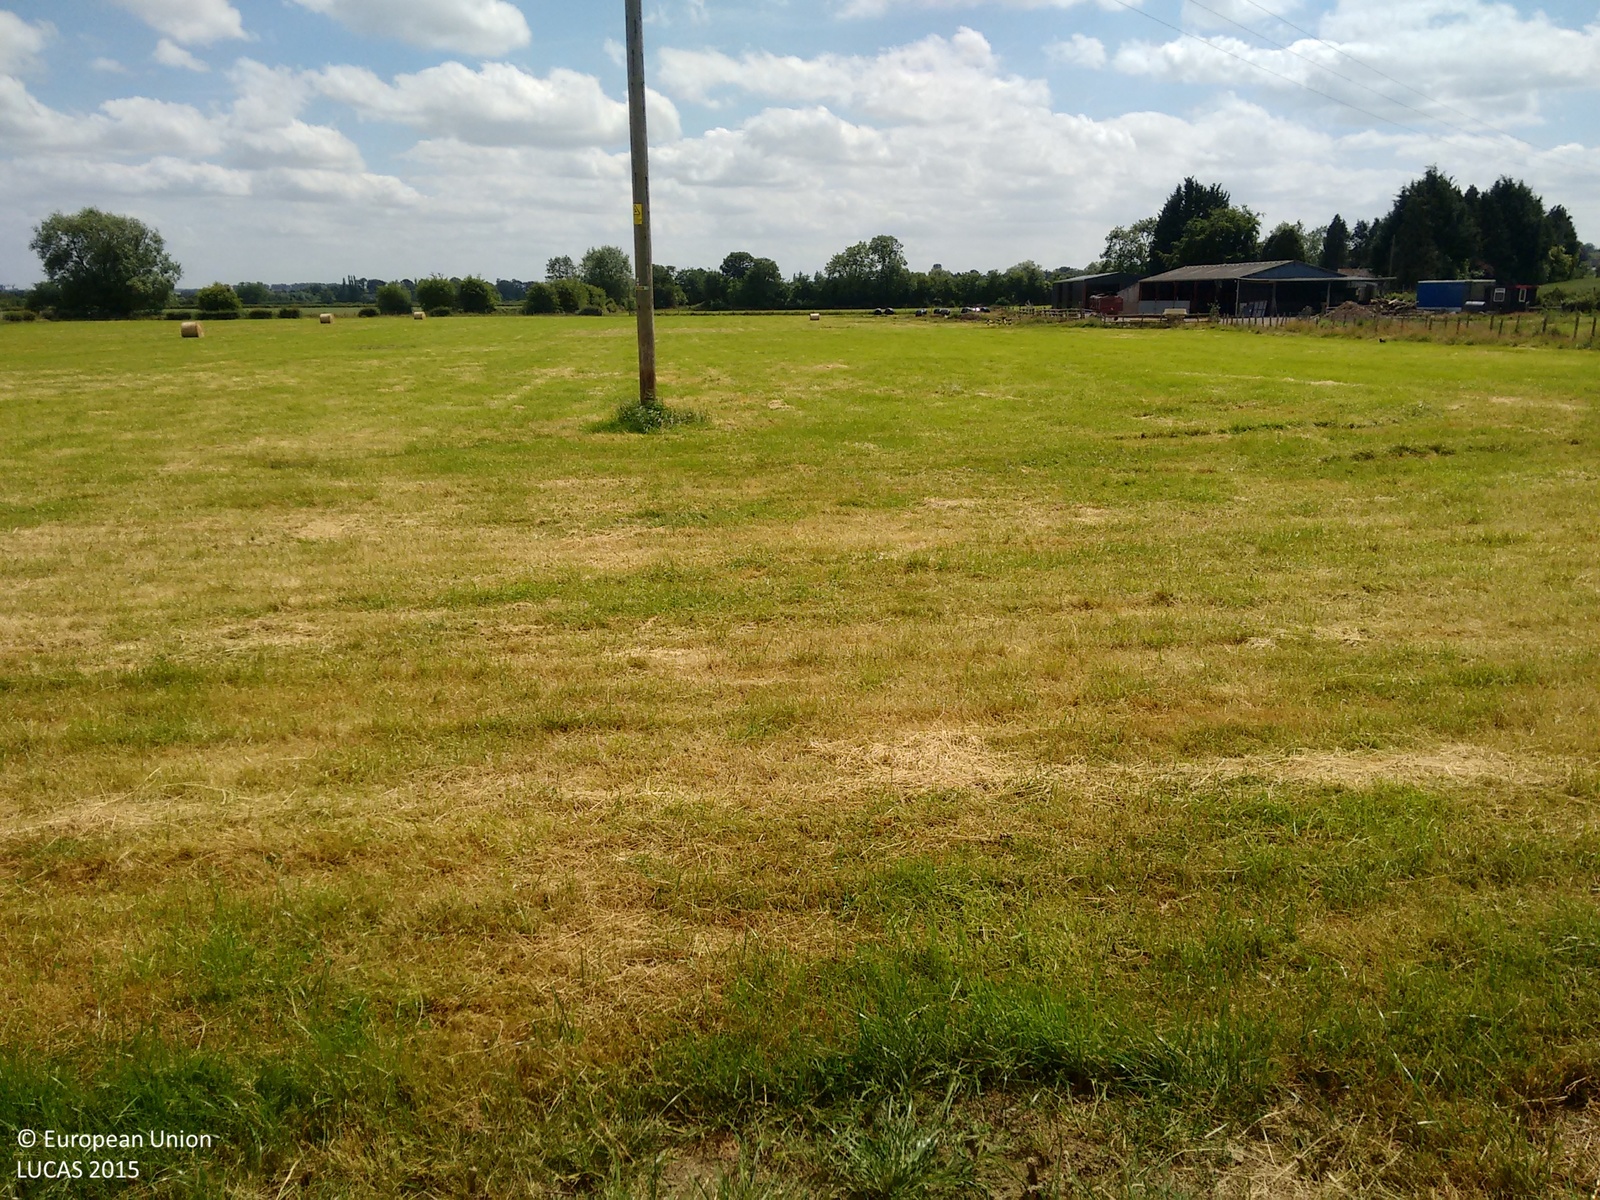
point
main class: Grassland
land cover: Grassland without tree/shrub cover
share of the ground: > 75 %
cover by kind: herbaceous plants 100 %
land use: Agriculture (excluding fallow land and kitchen gardens)
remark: Harvested field
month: June
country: GB
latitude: 52.2695
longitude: -2.7464
